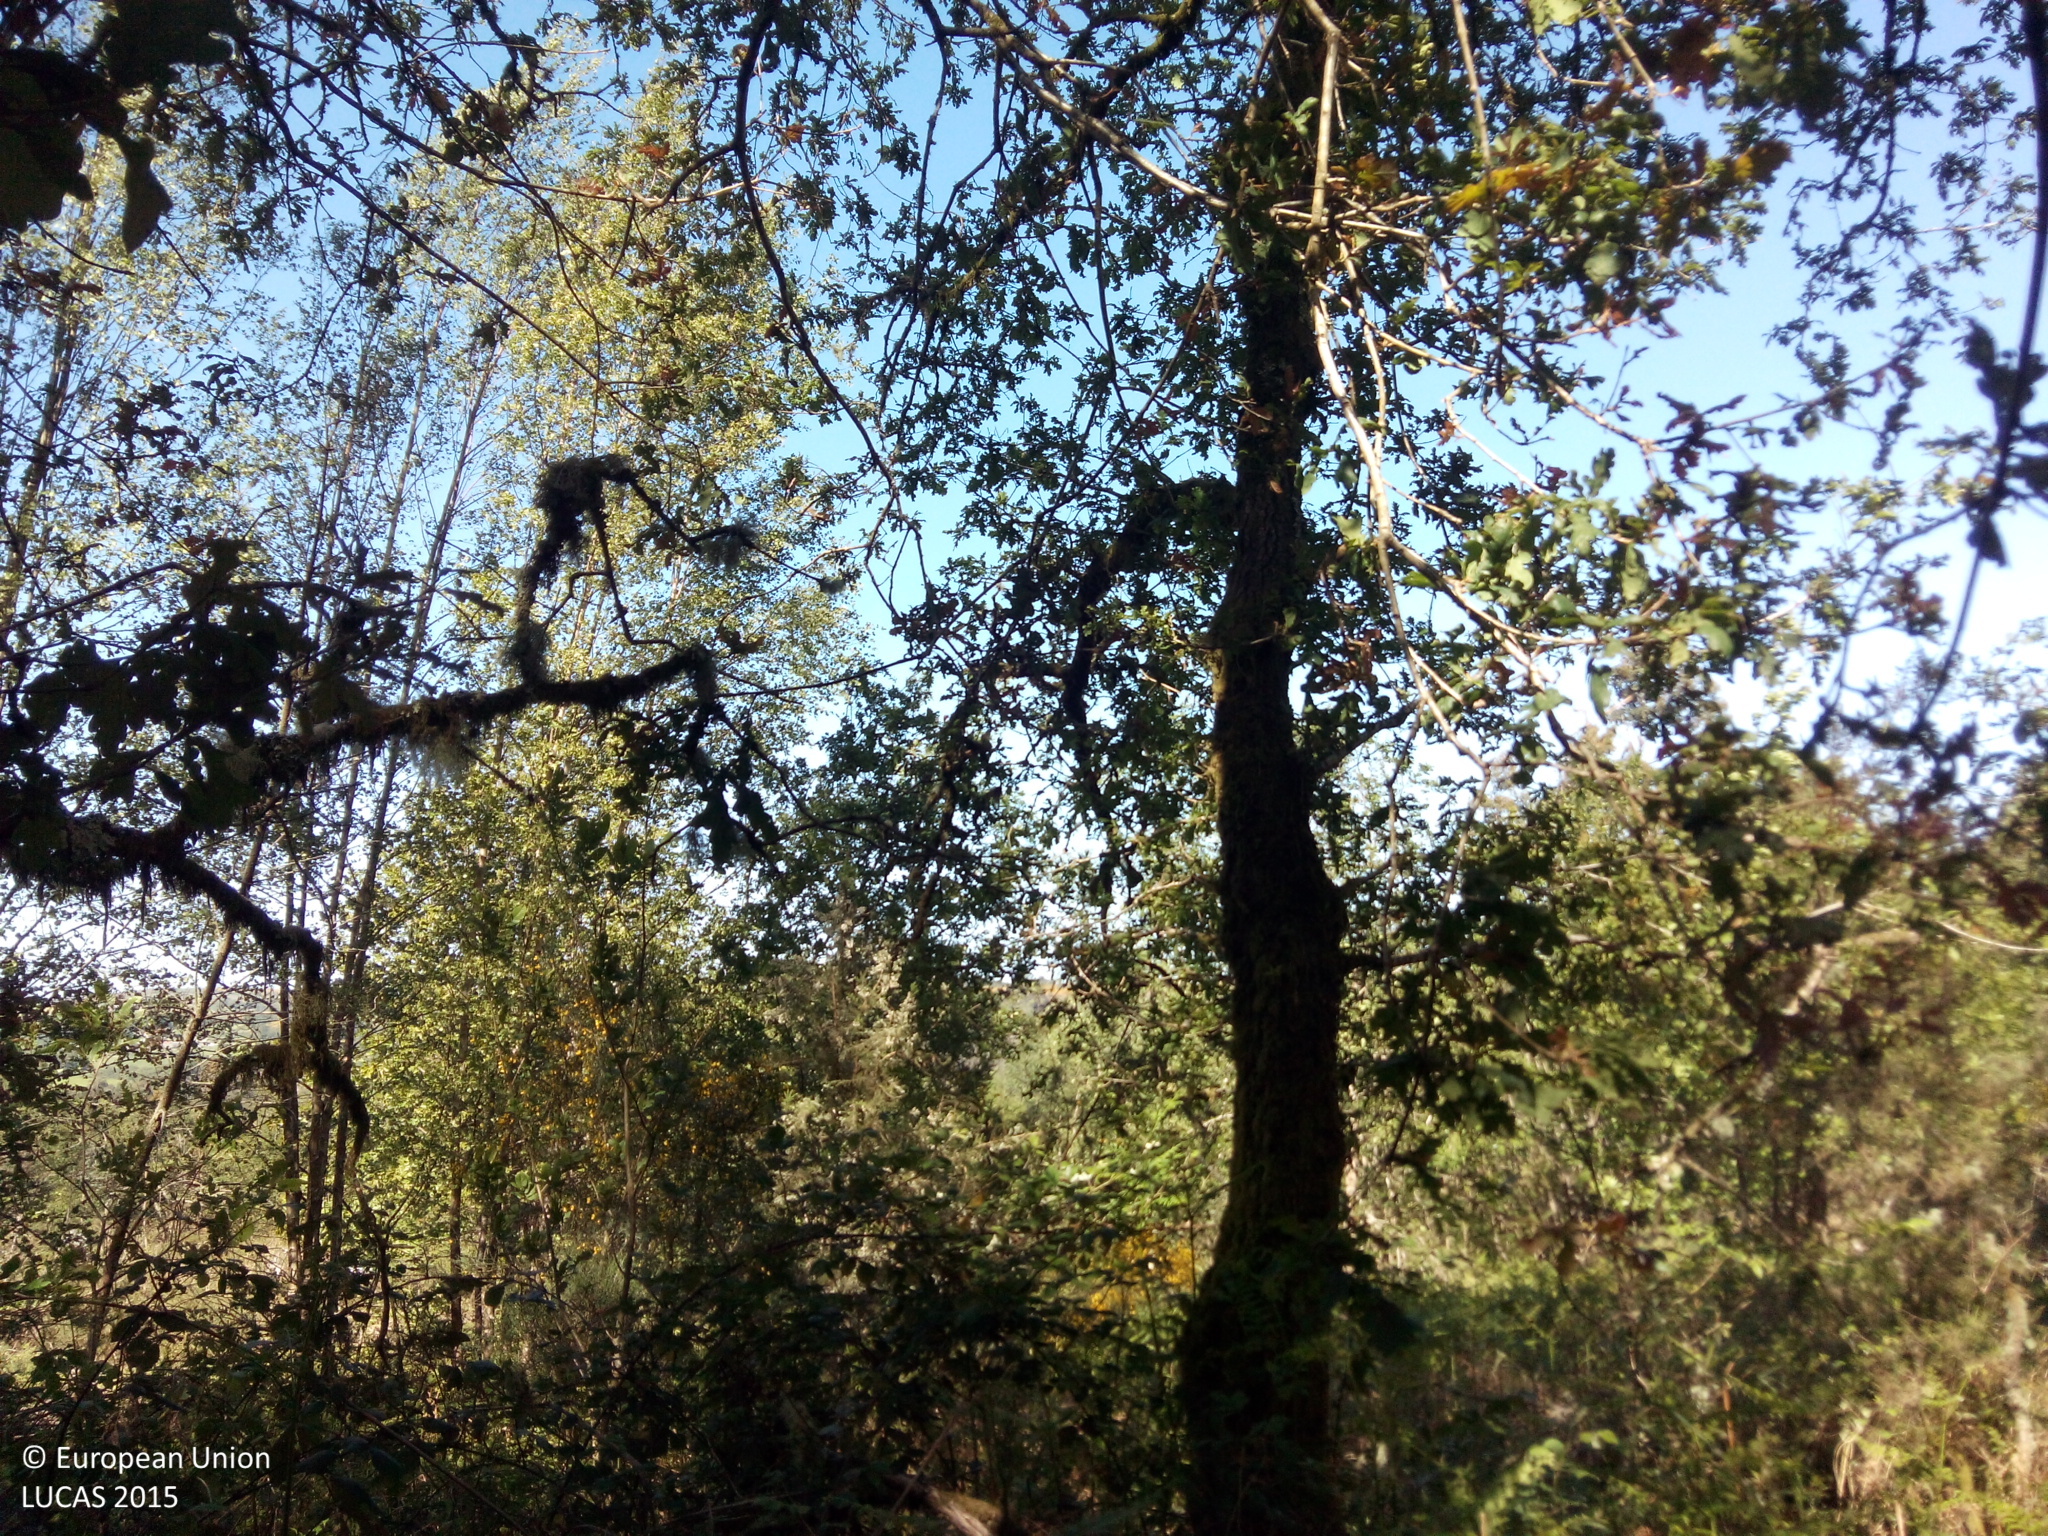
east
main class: Woodland
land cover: Broadleaved woodland
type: acidophilous oak and oak-birch forest
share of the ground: > 75 %
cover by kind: broadleaved forest trees 100 %
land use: Forestry
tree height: > 5 m
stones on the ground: 10 - 25 %
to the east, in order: Broadleaved woodland; Pine dominated mixed woodland; Ditches and canals; Paved roads, cycling and walking lanes; Broadleaved woodland; Temporary grasslands; Broadleaved woodland; Shrubland without tree cover; Broadleaved woodland
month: May
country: ES
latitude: 42.6364
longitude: -8.3767
